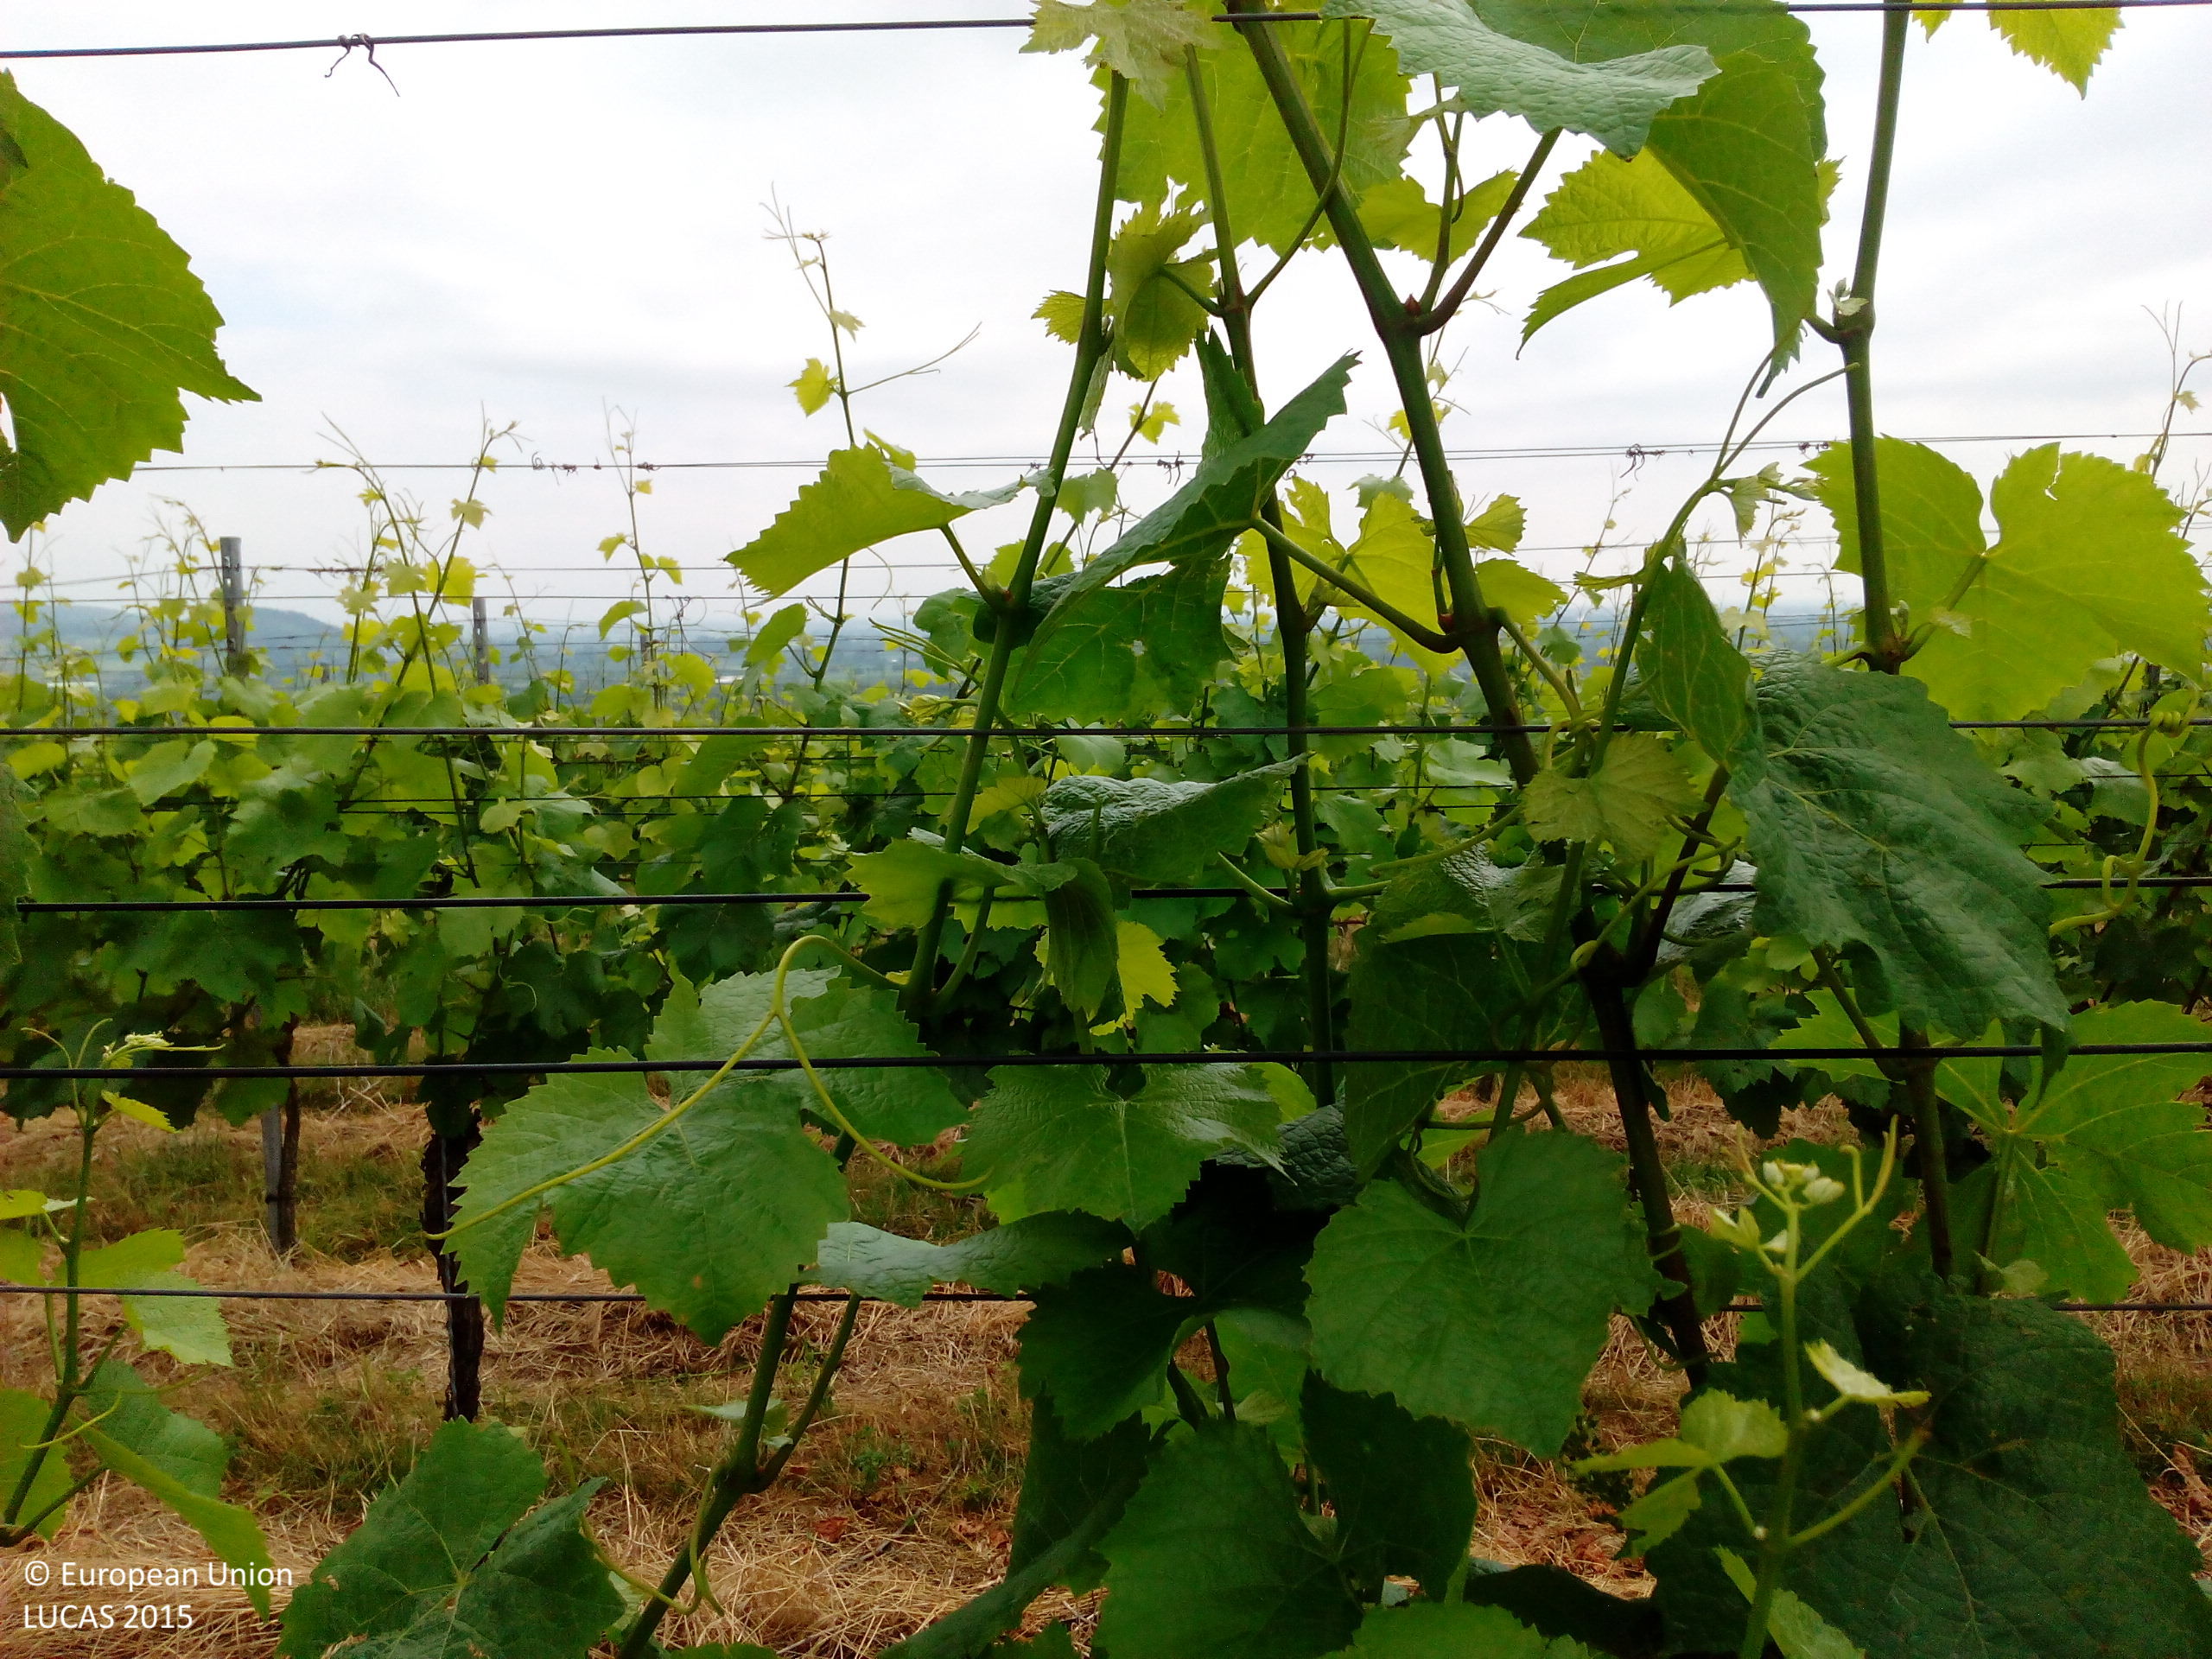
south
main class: Cropland
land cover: Vineyards
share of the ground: 25 - 50 %
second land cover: Grassland without tree/shrub cover
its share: 50 - 75 %
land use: Agriculture (excluding fallow land and kitchen gardens)
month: June
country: DE
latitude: 48.1074
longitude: 7.5971
